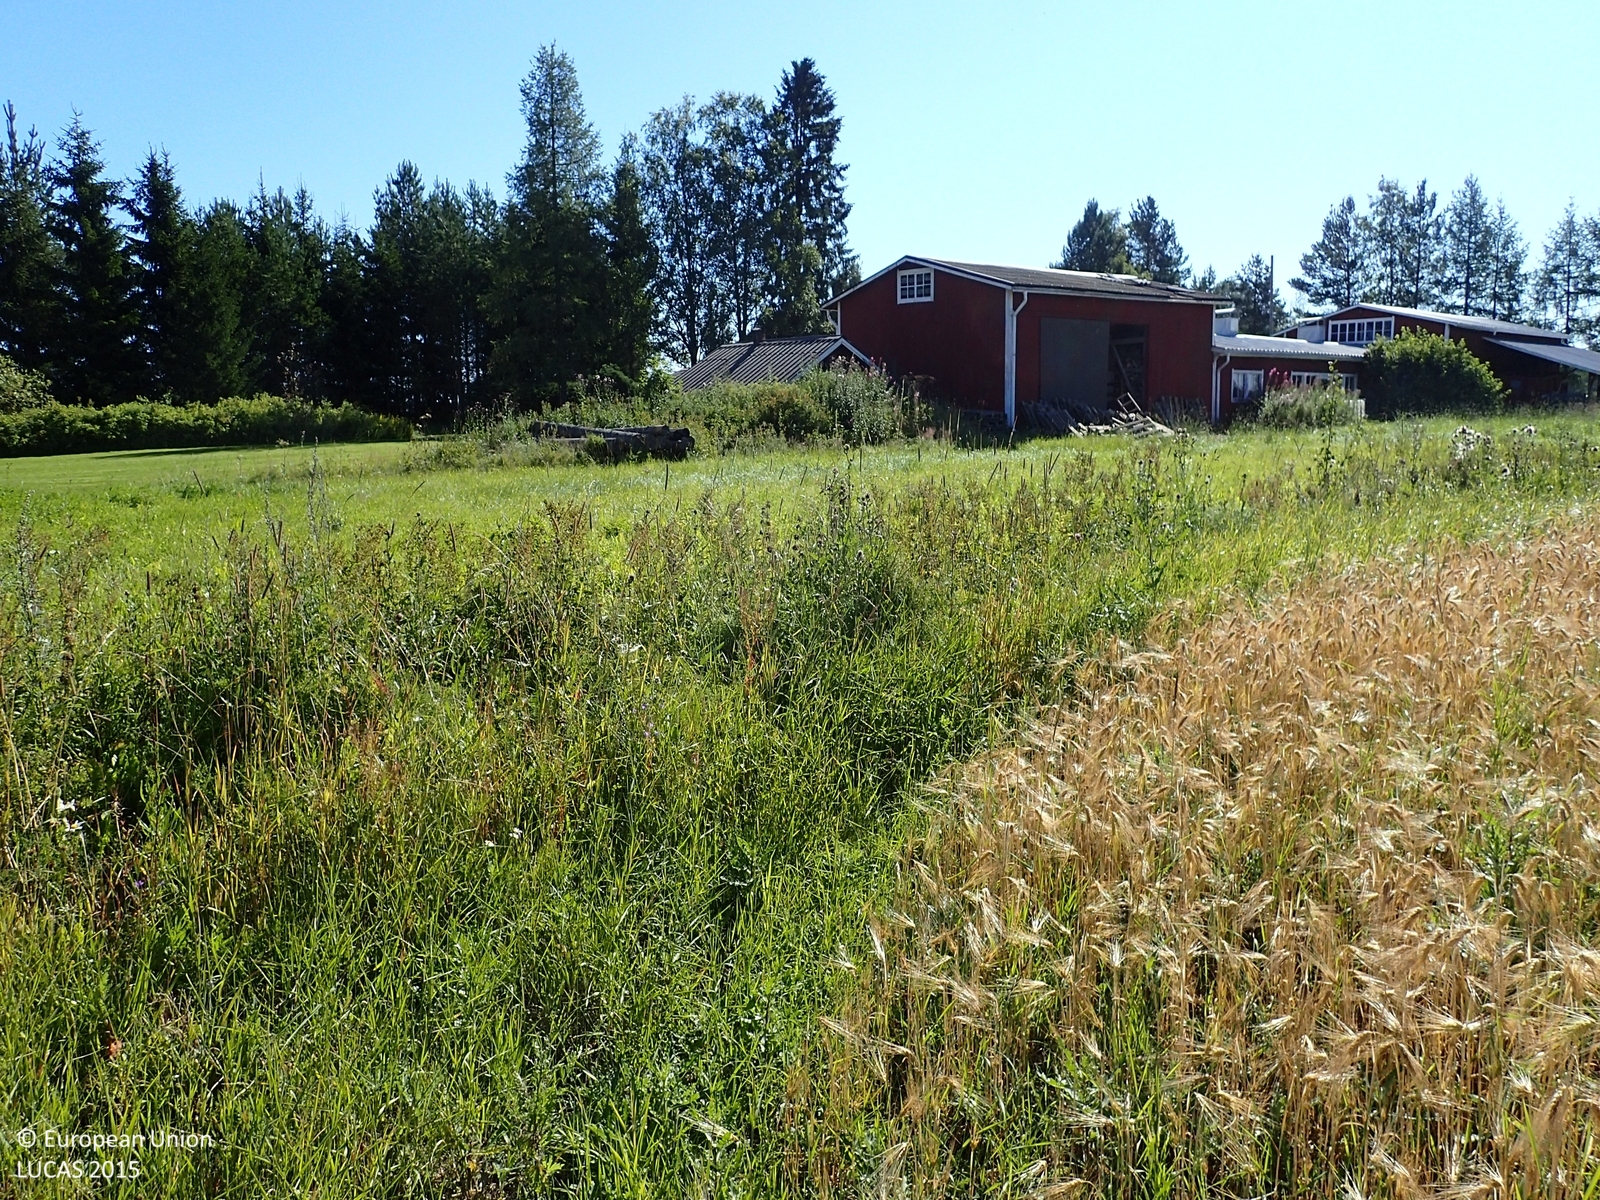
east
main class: Cropland
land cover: Barley
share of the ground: > 75 %
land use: Agriculture (excluding fallow land and kitchen gardens)
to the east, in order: Barley; Abandoned hedges; Ditches and canals; Abandoned hedges; Barley; Shruby margins; Ditches and canals; Grass margins; Paved roads, cycling and walking lanes; Grass margins; Ditches and canals; Grassland without tree/shrub cover
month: August
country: FI
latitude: 62.5354
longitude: 22.6321
